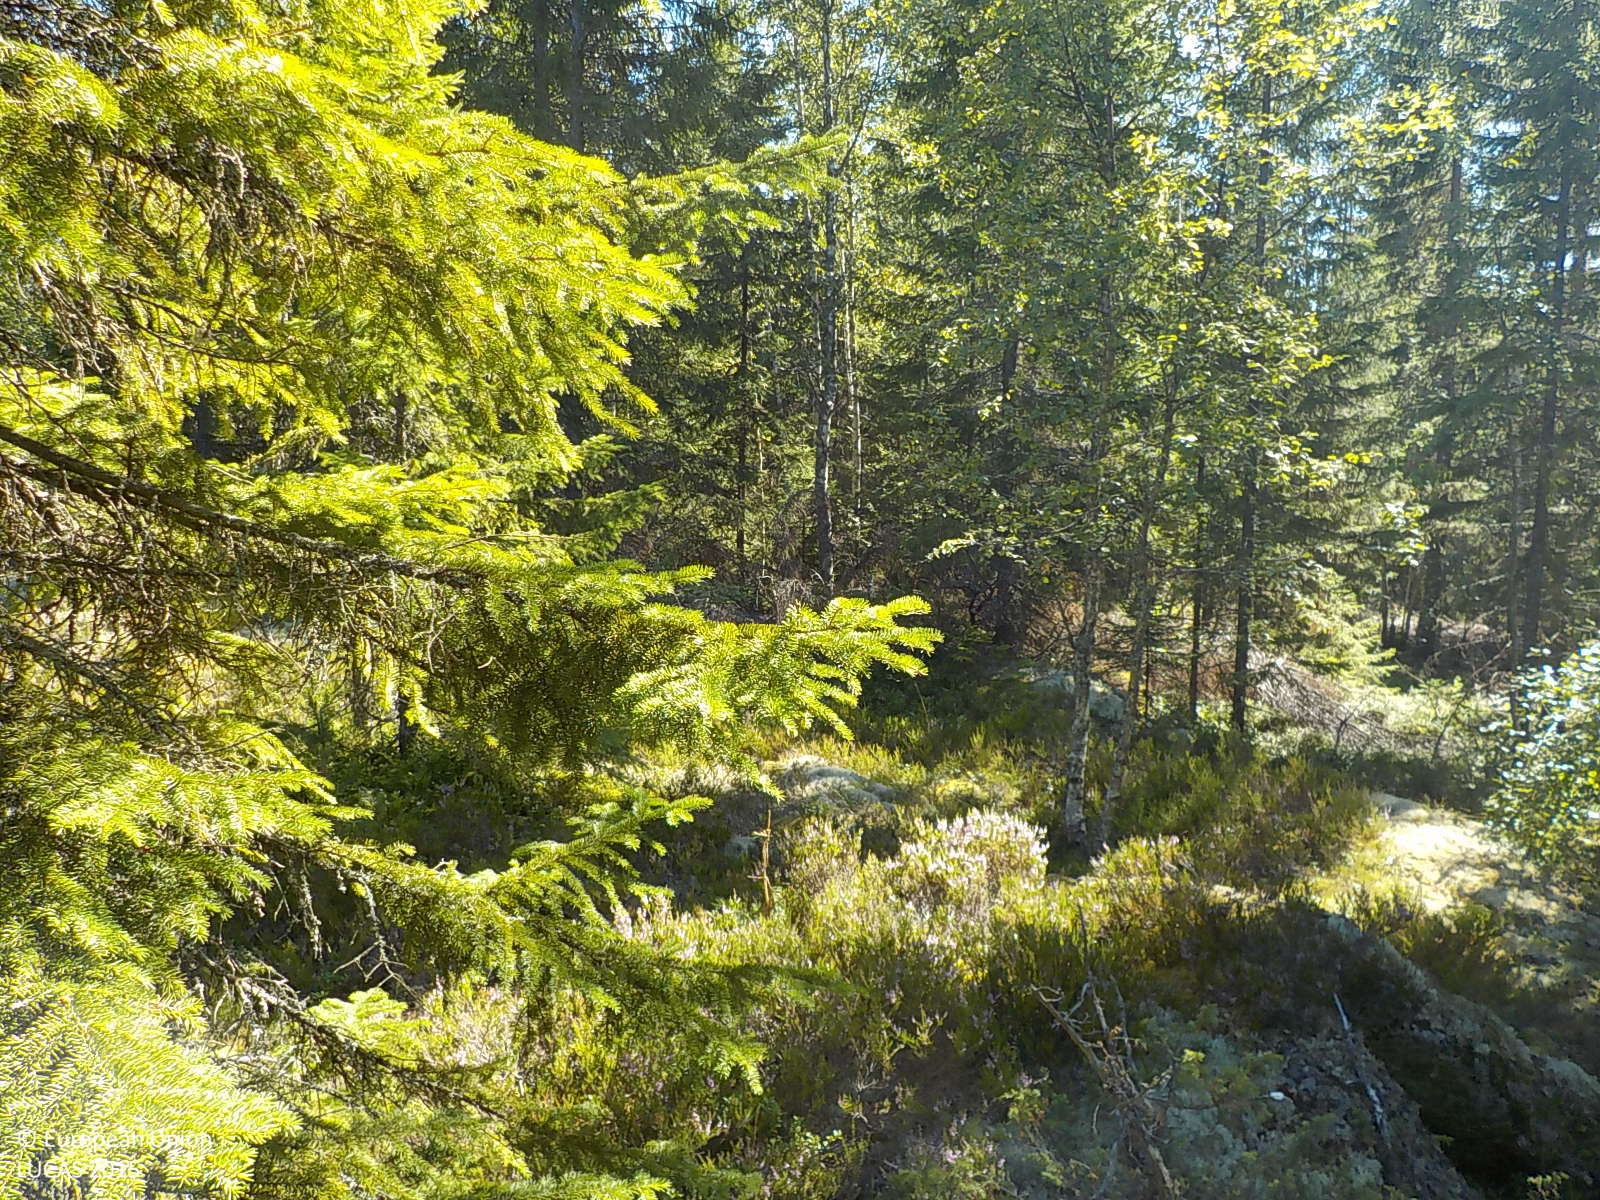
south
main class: Woodland
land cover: Spruce dominated mixed woodland
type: boreal forest
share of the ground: > 75 %
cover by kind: coniferous forest trees 60 %, broadleaved forest trees 20 %, herbaceous plants 20 %
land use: Forestry
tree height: > 5 m
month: August
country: SE
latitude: 63.3408
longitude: 18.7077
